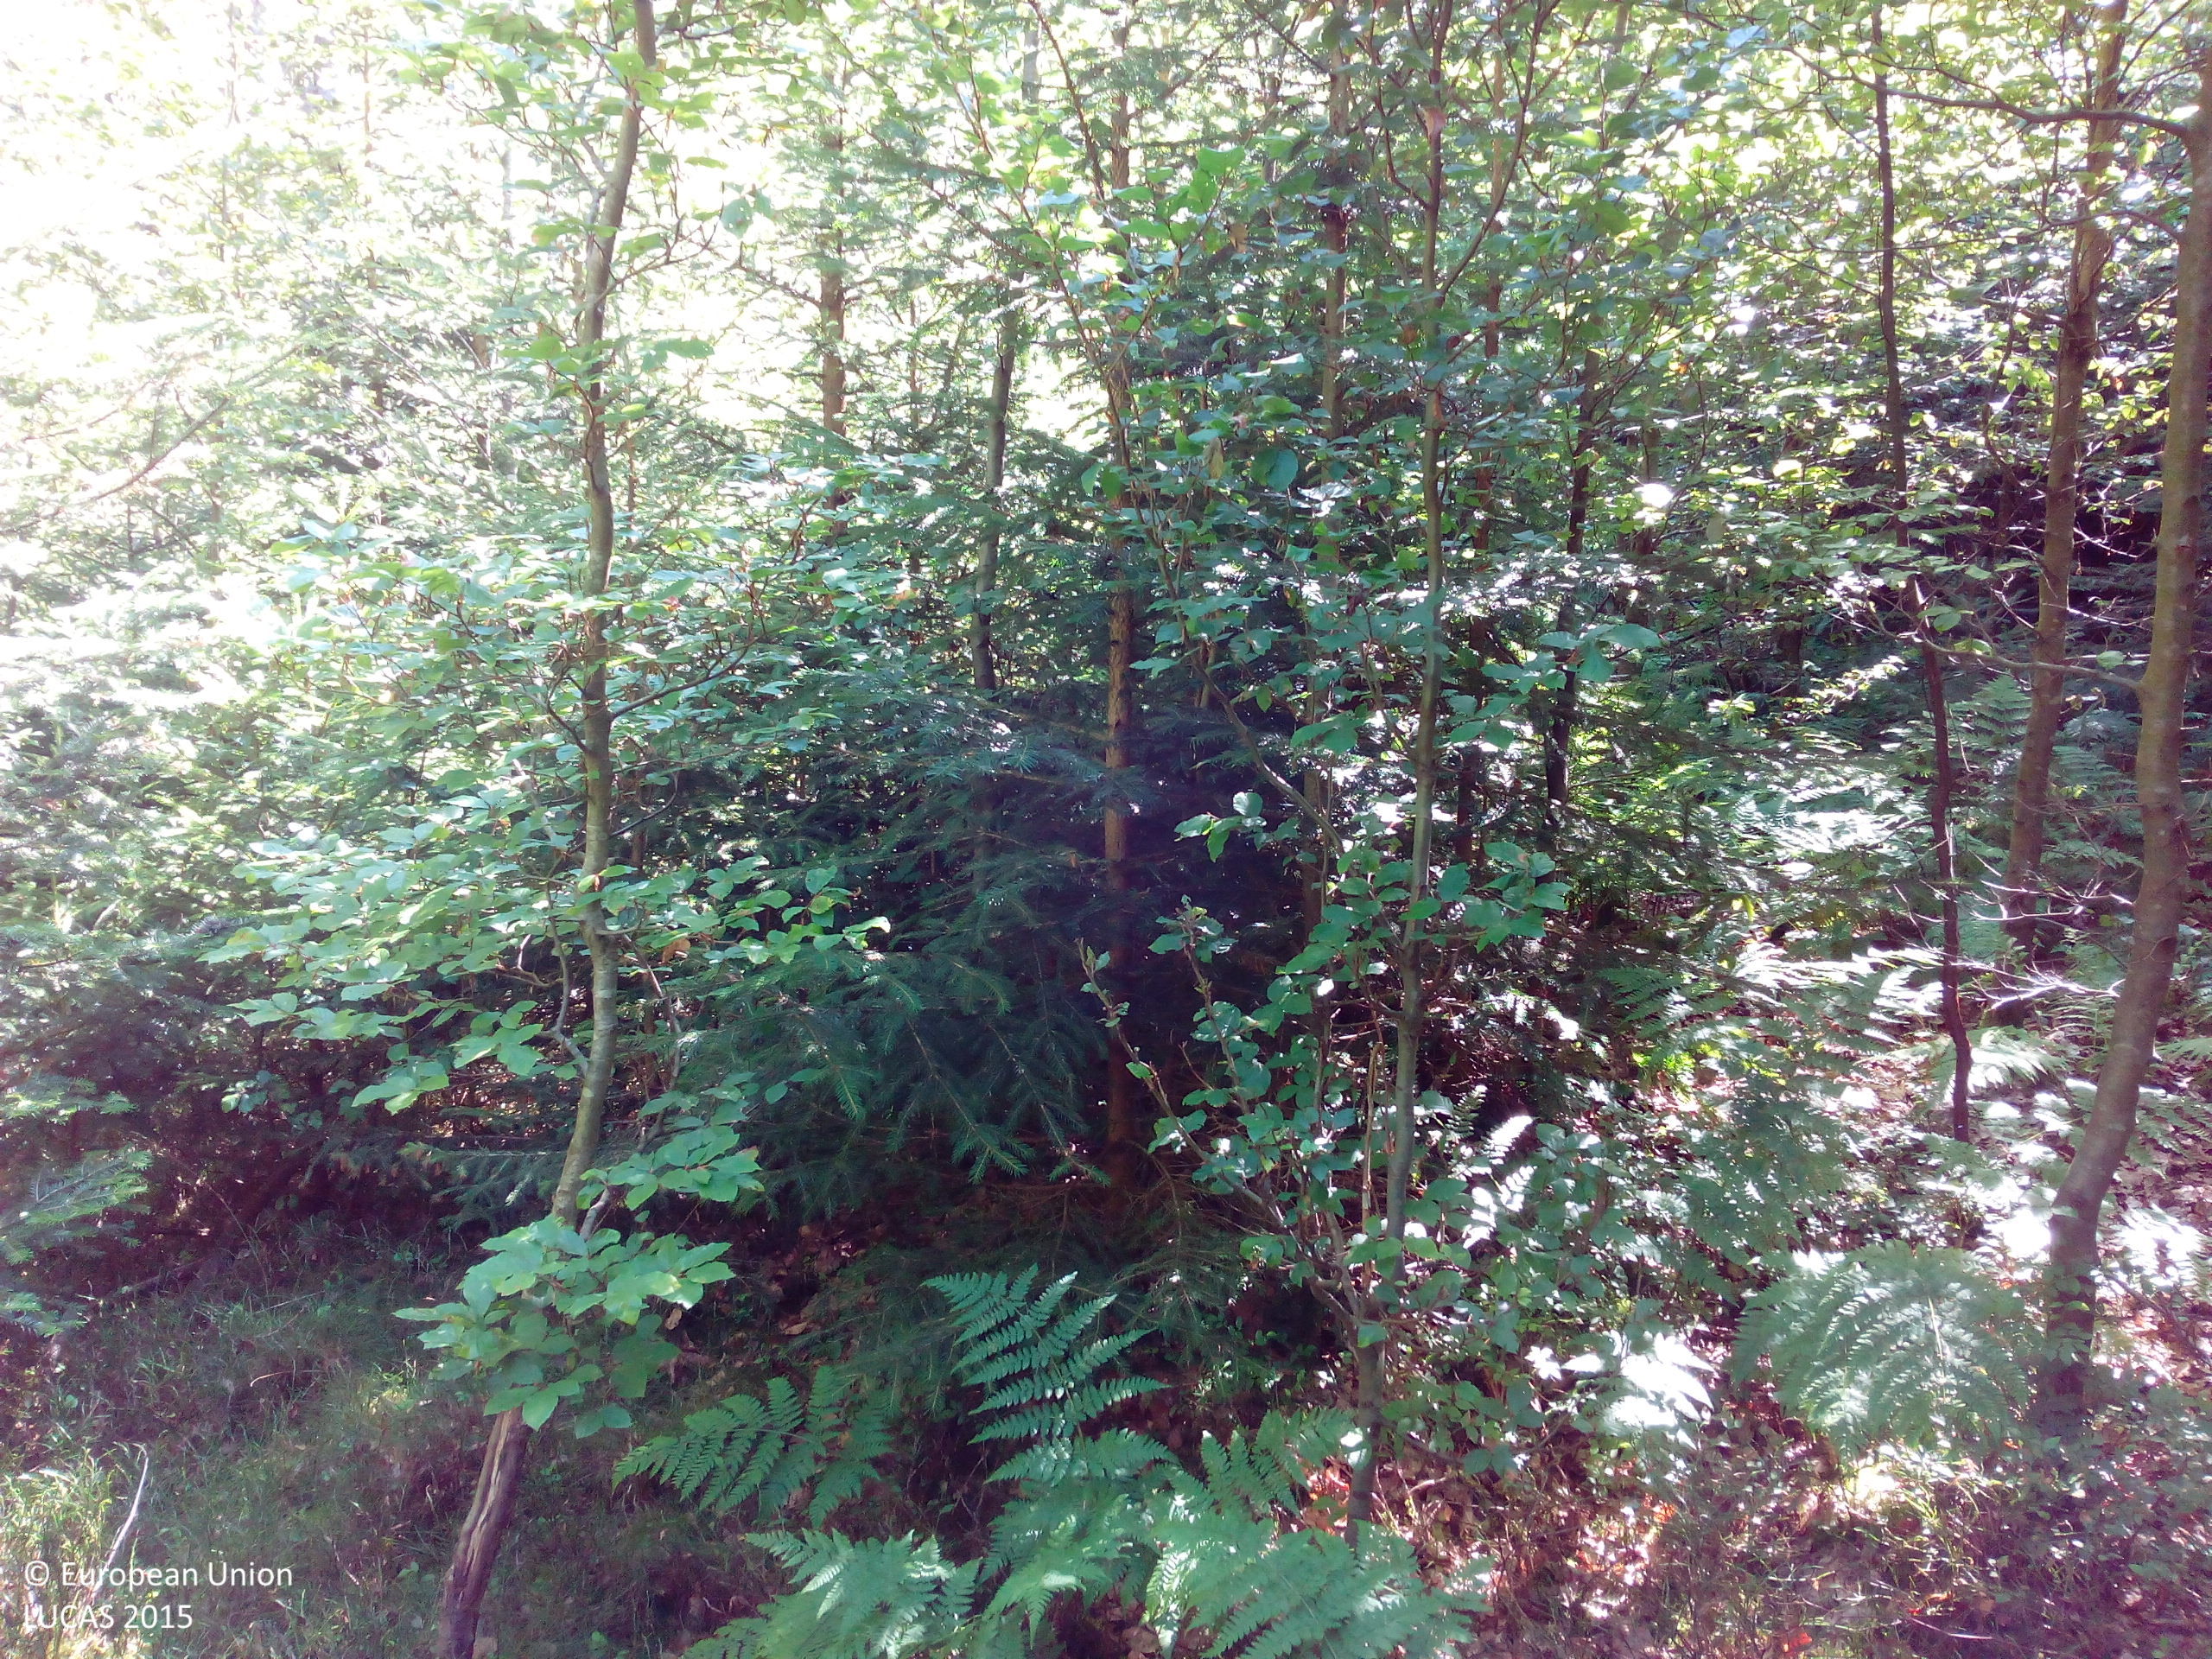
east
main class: Woodland
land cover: Other mixed woodland
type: beech forest
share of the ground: 50 - 75 %
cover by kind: broadleaved forest trees 40 %, coniferous forest trees 30 %, shrubs 10 %, unconsolidated bare surface 10 %, herbaceous plants 5 %, lichens and mosses 5 %
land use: Forestry
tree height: > 5 m
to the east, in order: Other mixed woodland; Other coniferous woodland; Spruce dominated coniferous woodland; Other coniferous woodland; Other mixed woodland; Spruce dominated coniferous woodland; Grassland without tree/shrub cover; Other structural elements; Grassland without tree/shrub cover; Spruce dominated coniferous woodland; Groves; Spontaneously vegetated surfaces; Grassland without tree/shrub cover
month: August
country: DE
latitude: 47.9743
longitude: 8.1659
